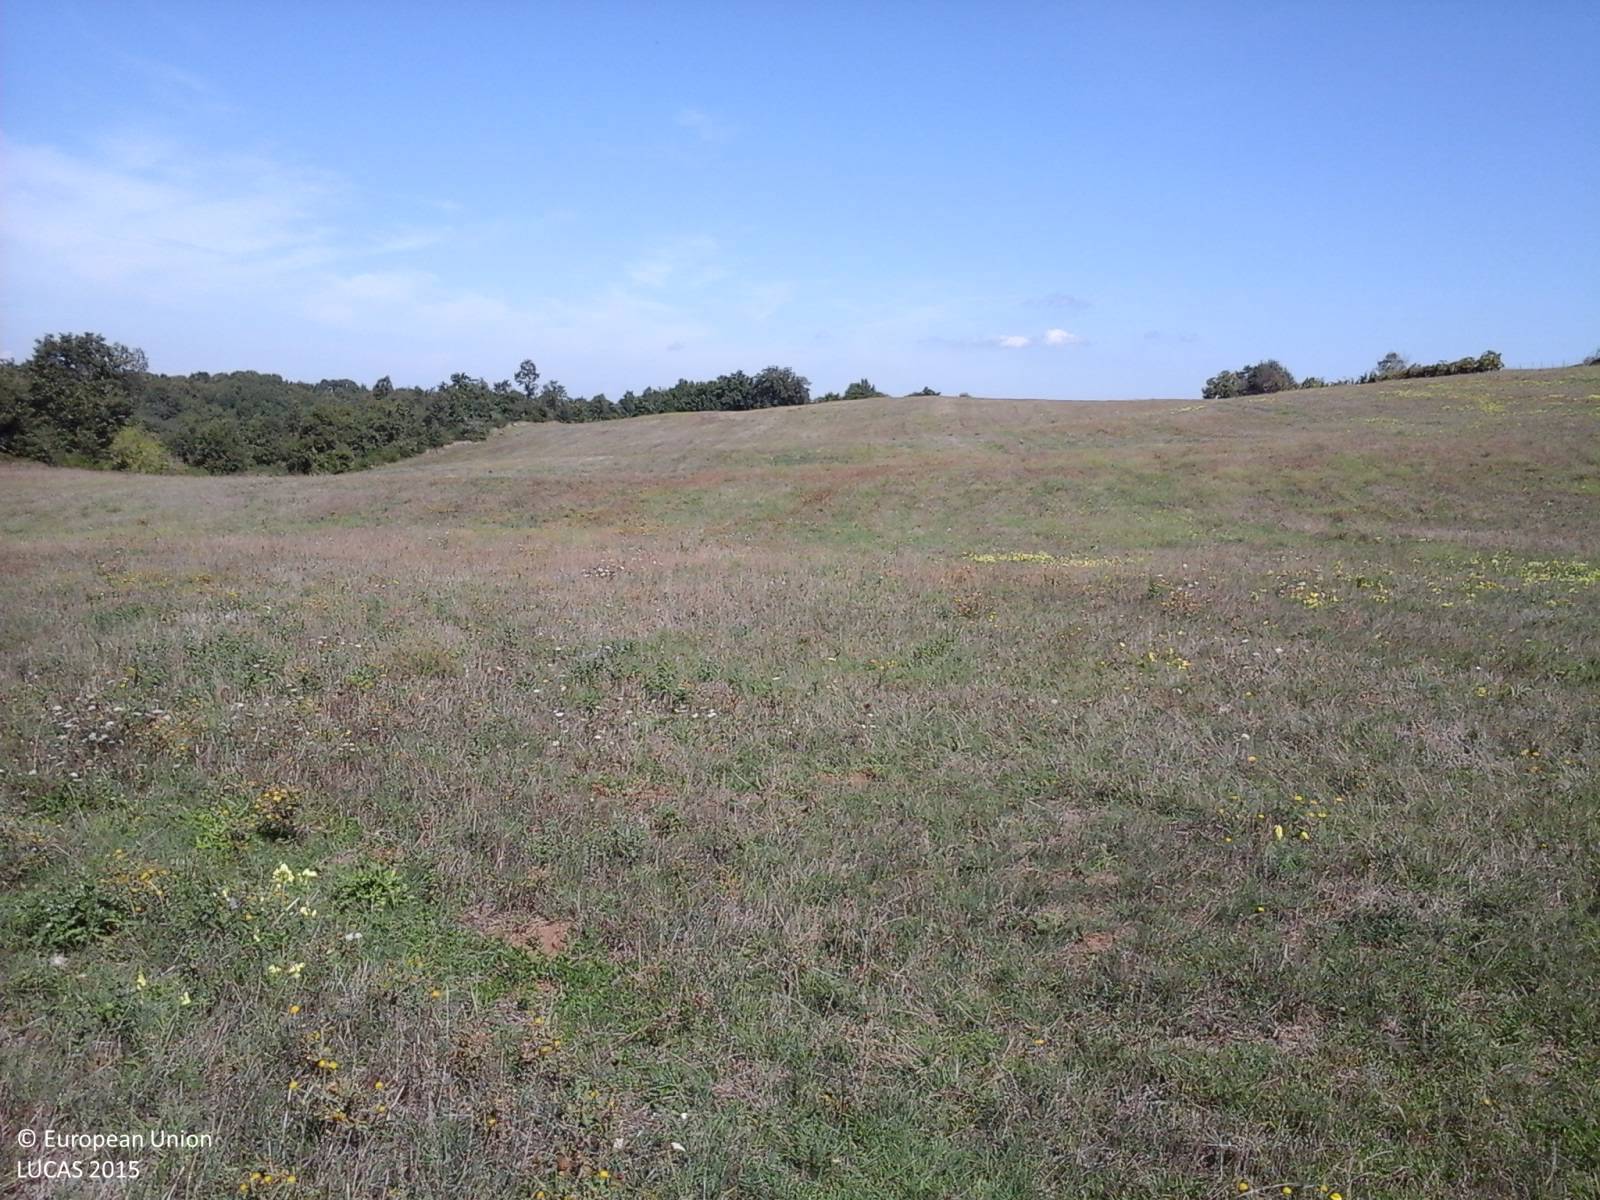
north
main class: Grassland
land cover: Grassland without tree/shrub cover
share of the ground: > 75 %
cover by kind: herbaceous plants 100 %
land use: Agriculture (excluding fallow land and kitchen gardens)
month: September
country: IT
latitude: 42.6874
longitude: 12.0560
